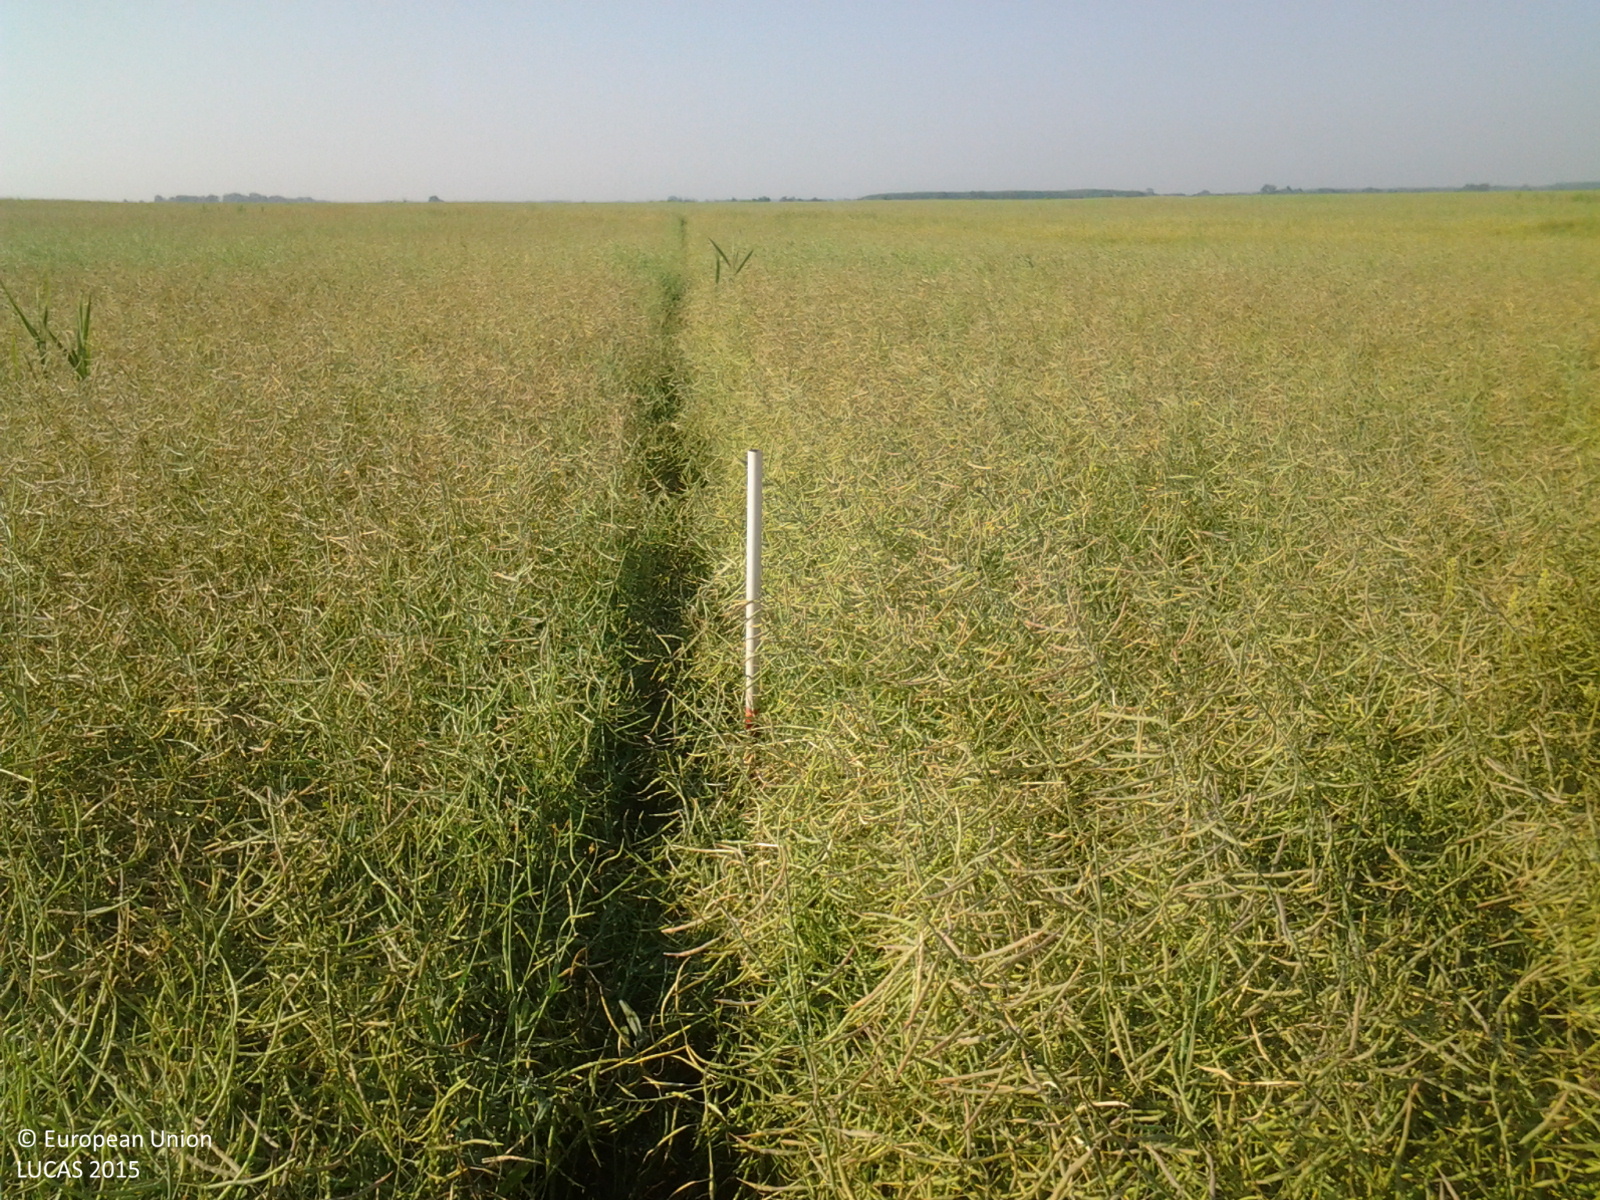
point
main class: Cropland
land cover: Rape and turnip rape
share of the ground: > 75 %
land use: Agriculture (excluding fallow land and kitchen gardens)
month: June
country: HU
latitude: 46.5931
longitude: 18.9284
